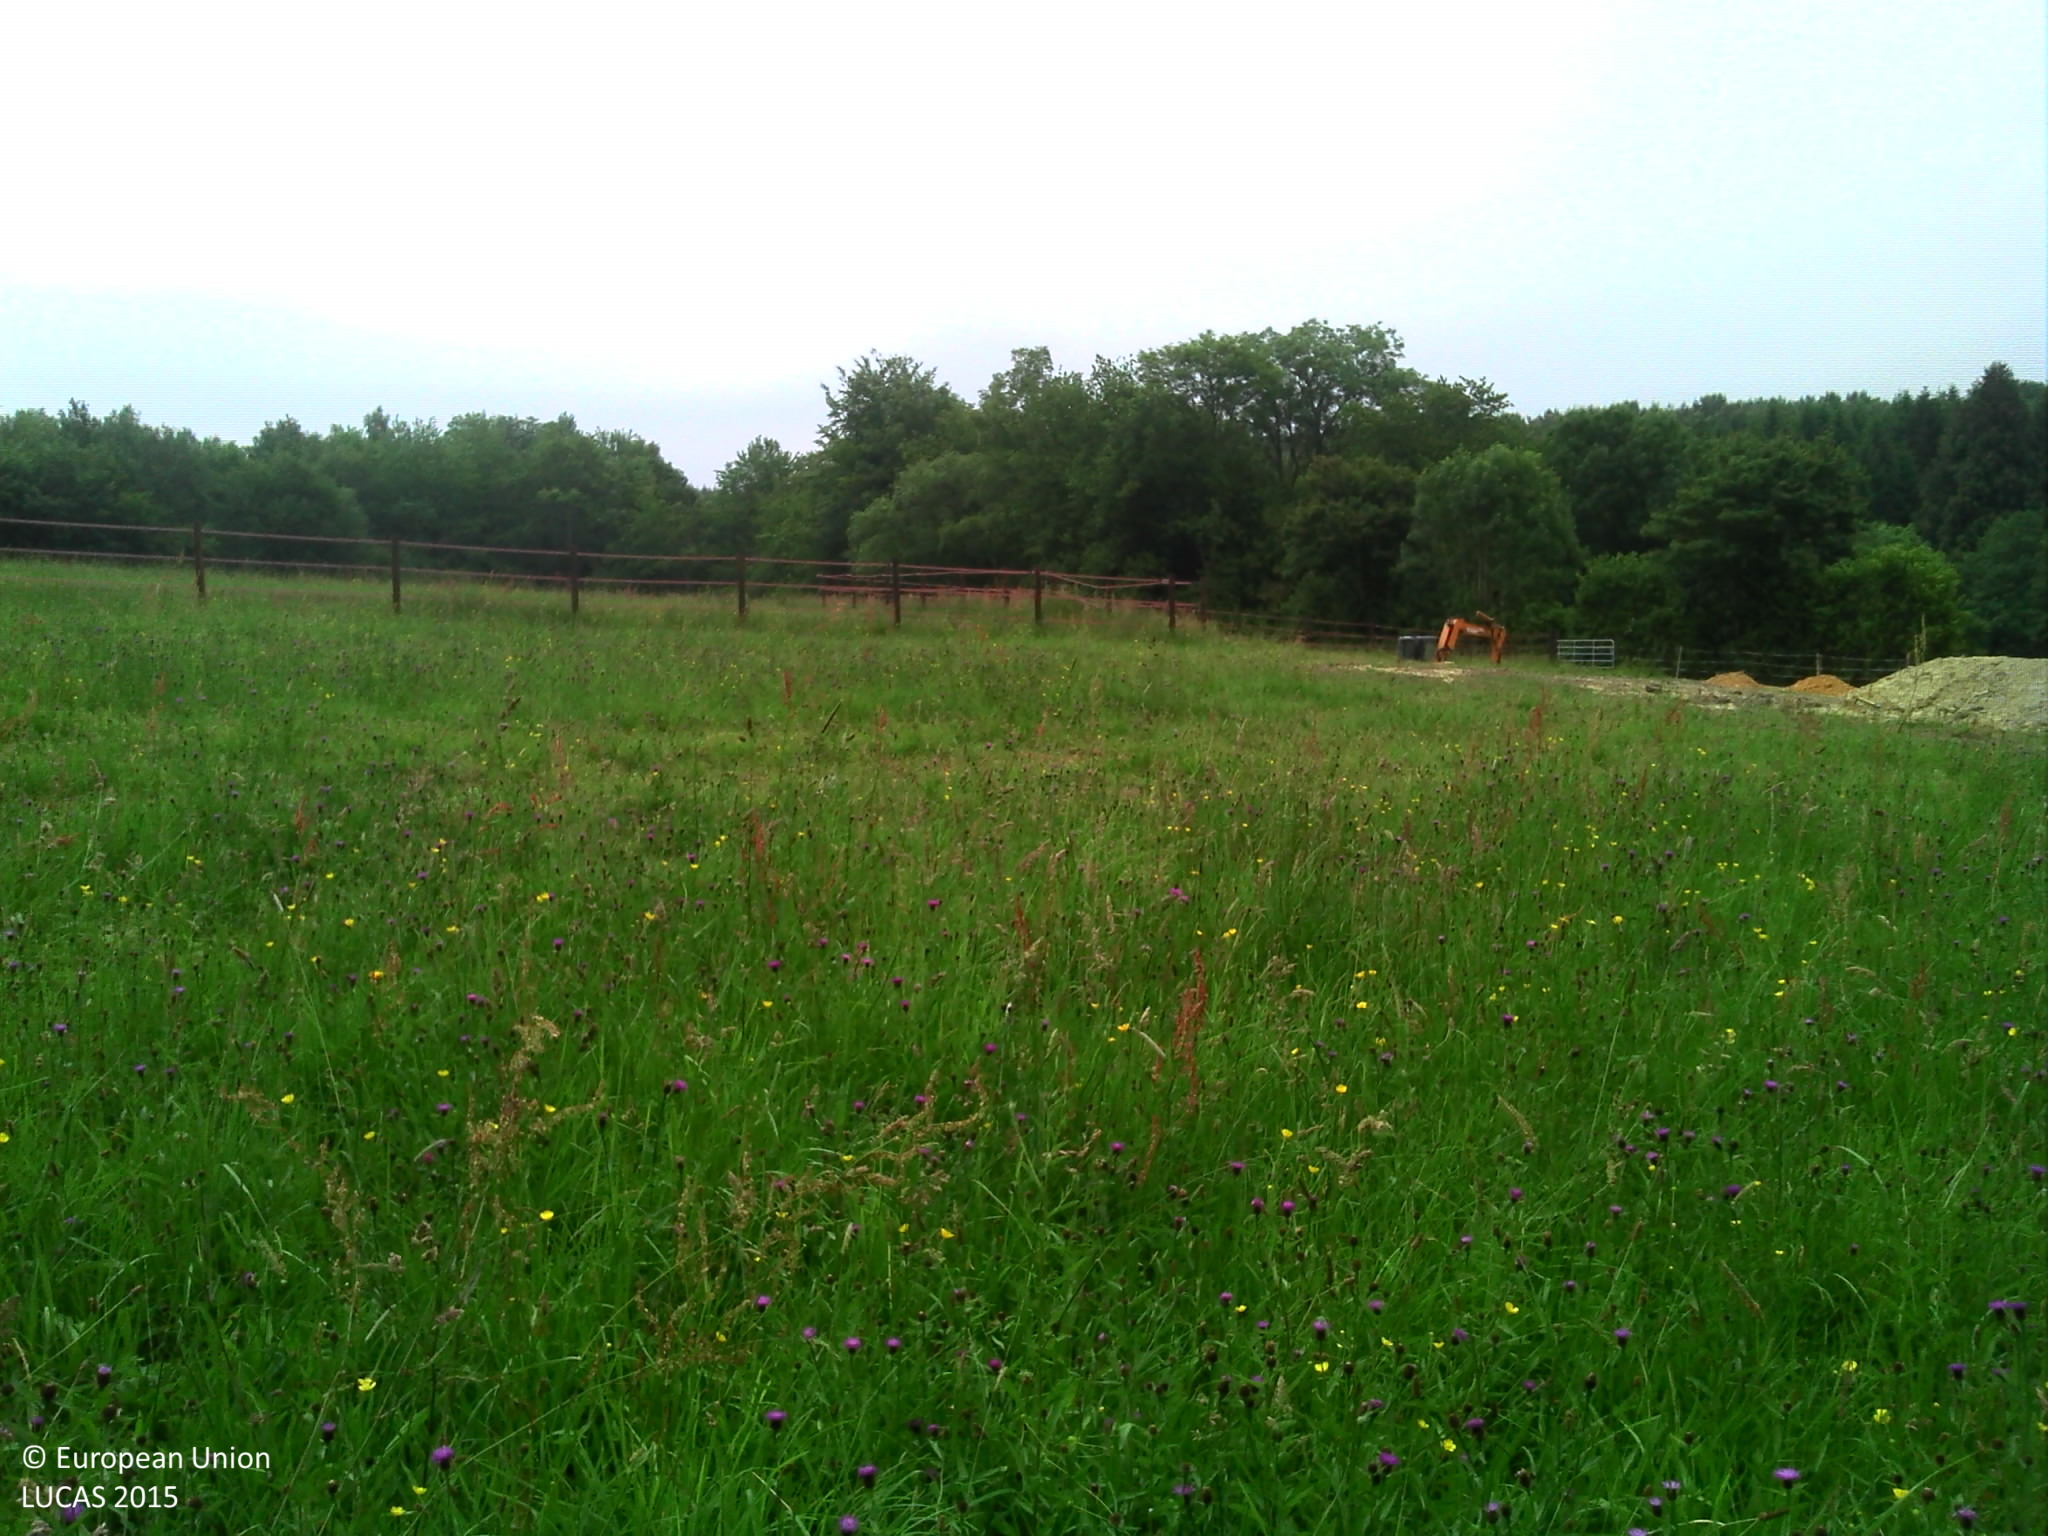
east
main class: Grassland
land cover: Grassland without tree/shrub cover
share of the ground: > 75 %
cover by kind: herbaceous plants 100 %
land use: Agriculture (excluding fallow land and kitchen gardens)
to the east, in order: Grassland without tree/shrub cover; Fences; Grassland without tree/shrub cover; Fences; Broadleaved woodland; Spruce dominated coniferous woodland
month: June
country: FR
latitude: 49.1554
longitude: 0.1114
